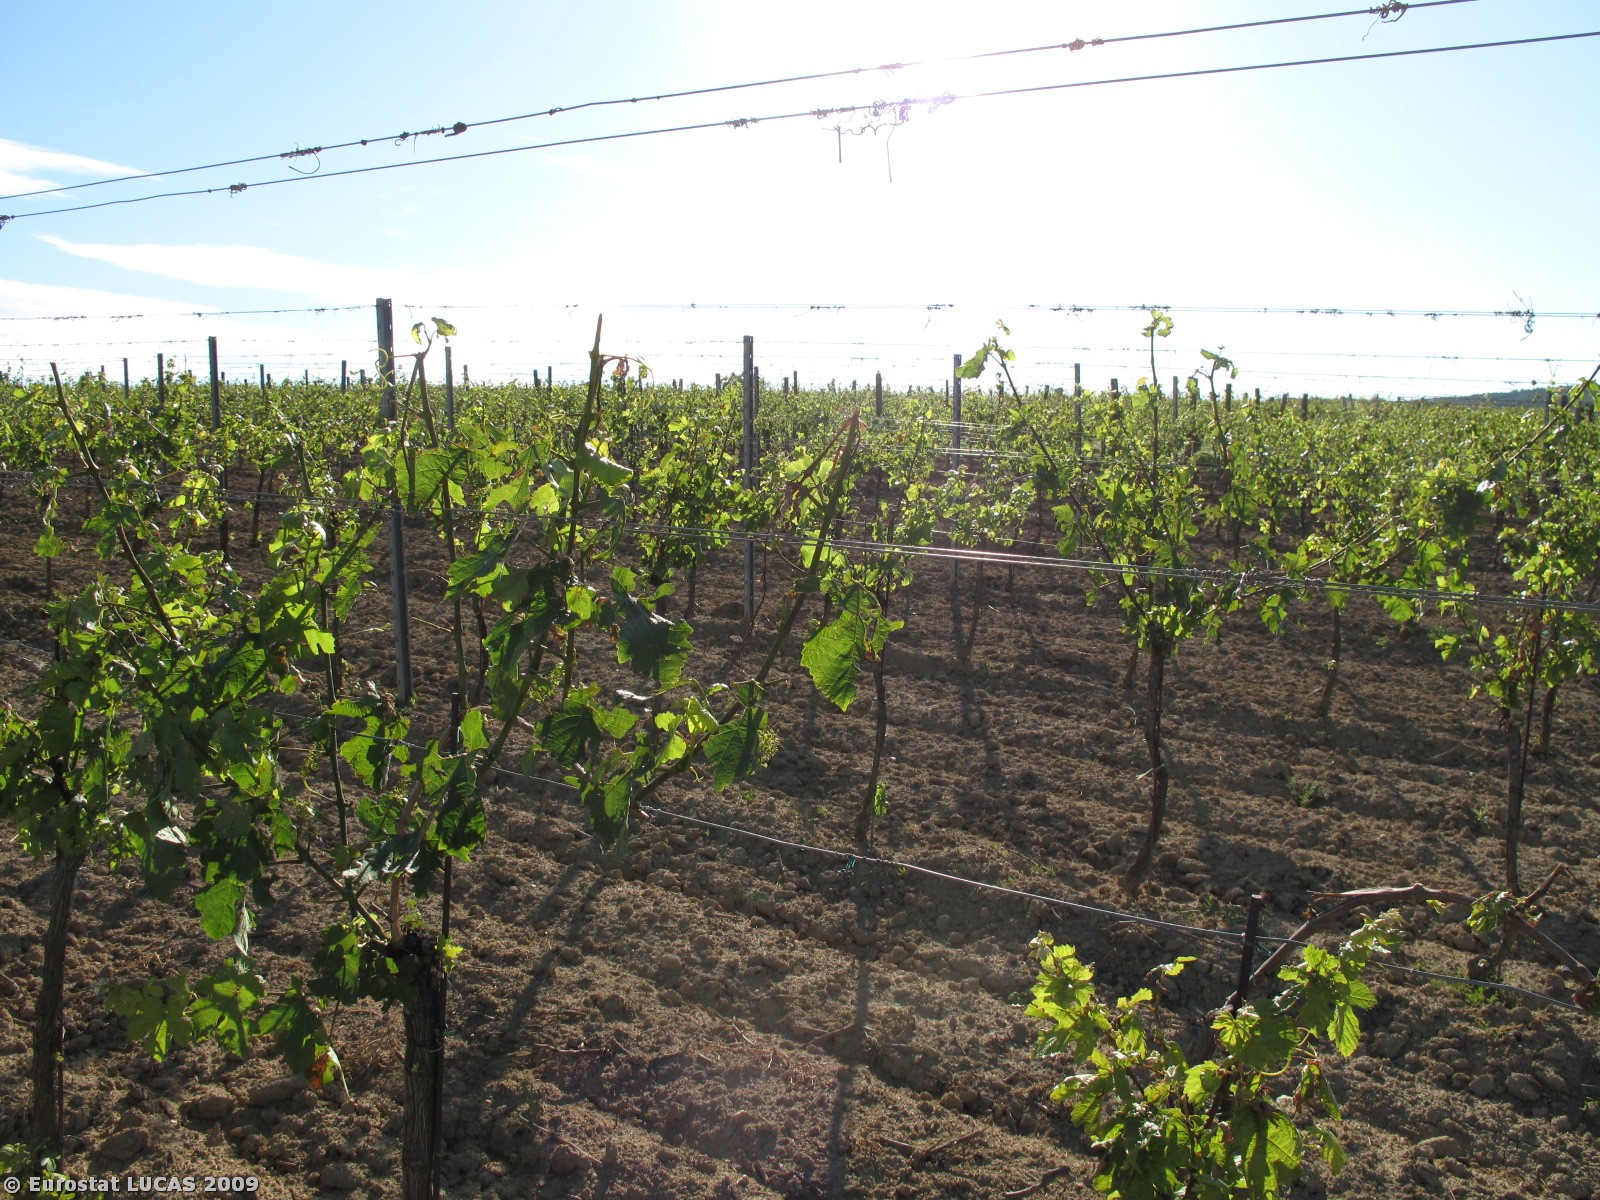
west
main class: Cropland
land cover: Vineyards
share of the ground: 10 - 25 %
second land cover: Bare land
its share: > 75 %
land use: Agriculture (excluding fallow land and kitchen gardens)
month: June
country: AT
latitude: 48.7500
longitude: 15.9207
